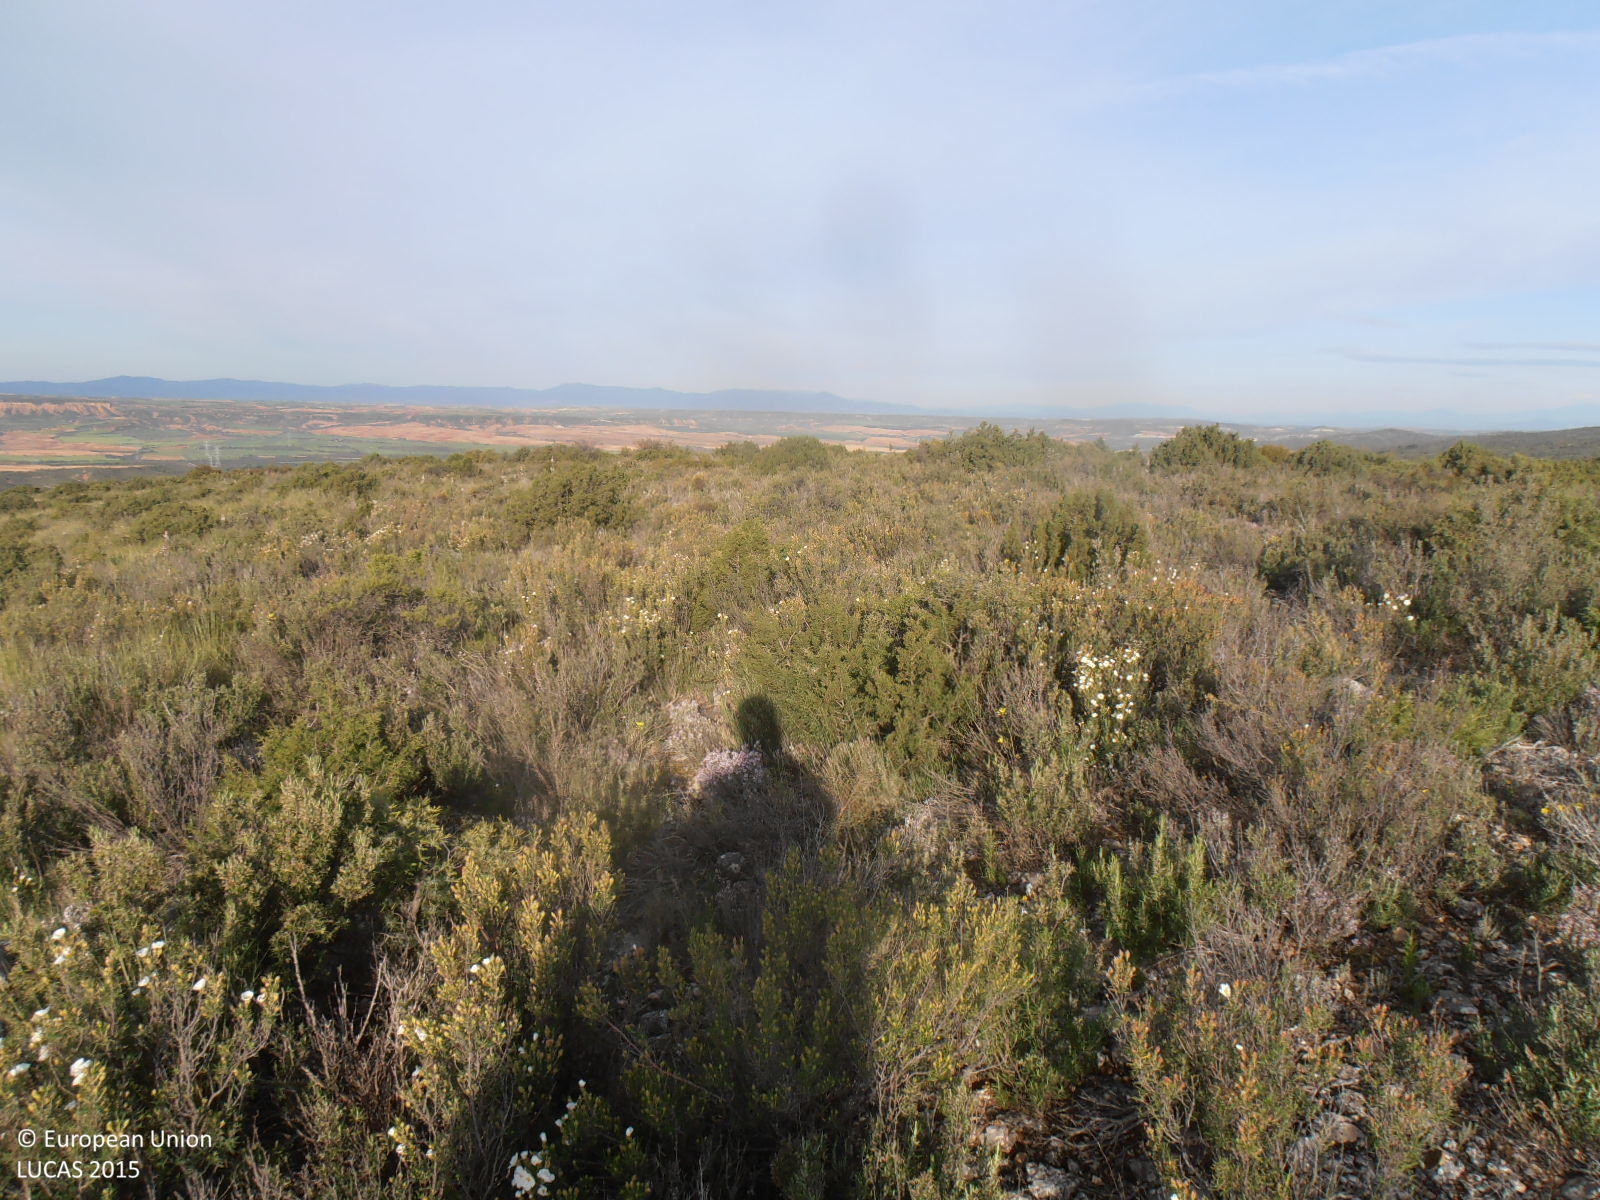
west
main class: Shrubland
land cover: Shrubland with sparse tree cover
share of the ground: > 75 %
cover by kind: shrubs 80 %, consolidated bare surface 10 %, coniferous forest trees 5 %, herbaceous plants 5 %
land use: Semi-natural and natural areas not in use
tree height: < 5 m
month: April
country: ES
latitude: 41.3959
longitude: -1.0120
